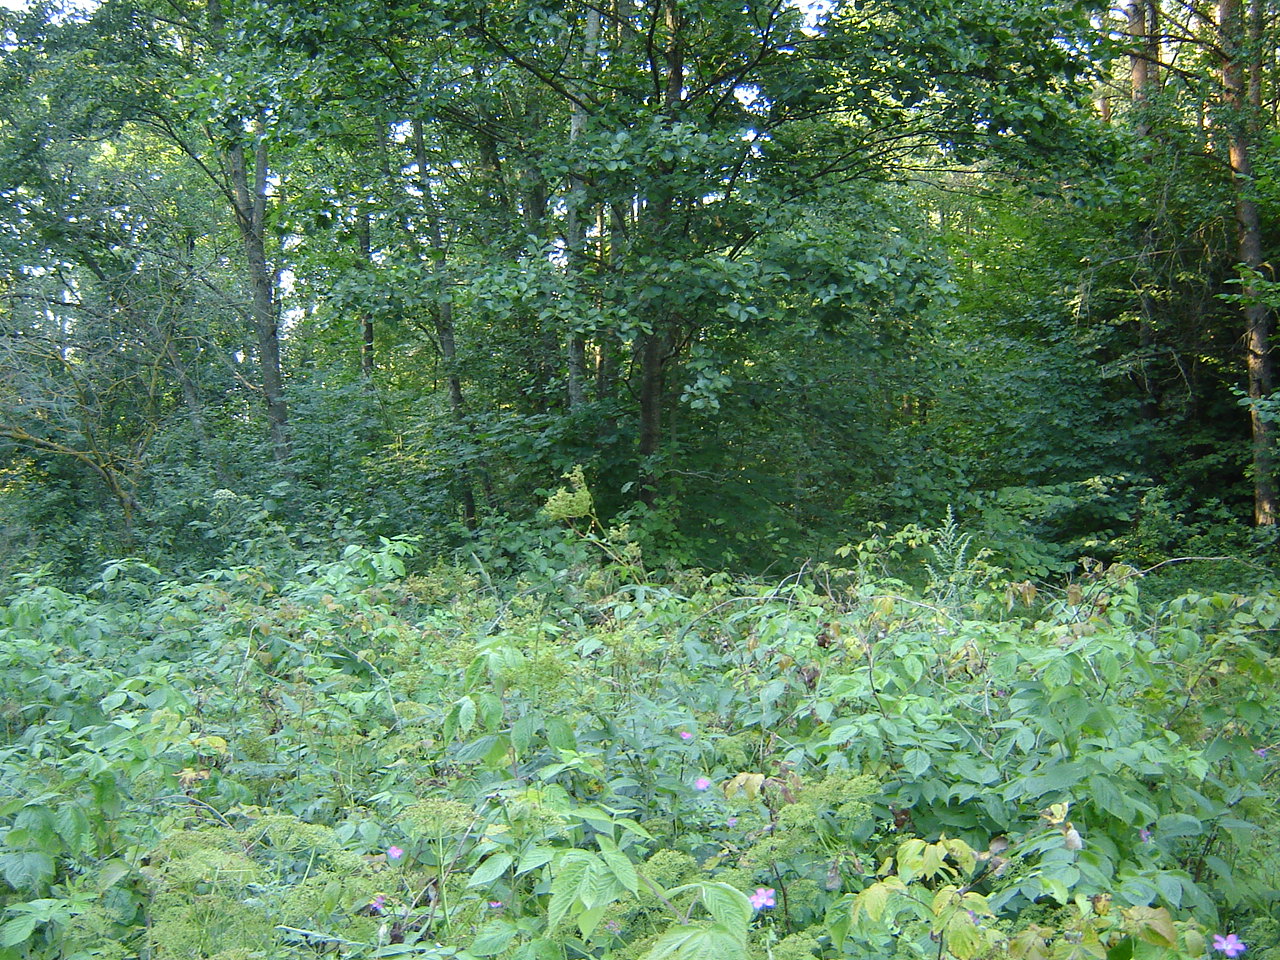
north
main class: Shrubland
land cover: Shrubland with sparse tree cover
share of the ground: 25 - 50 %
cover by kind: herbaceous plants 60 %, shrubs 35 %, broadleaved forest trees 5 %
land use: Forestry
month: August
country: LT
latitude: 55.1840
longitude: 25.3395
